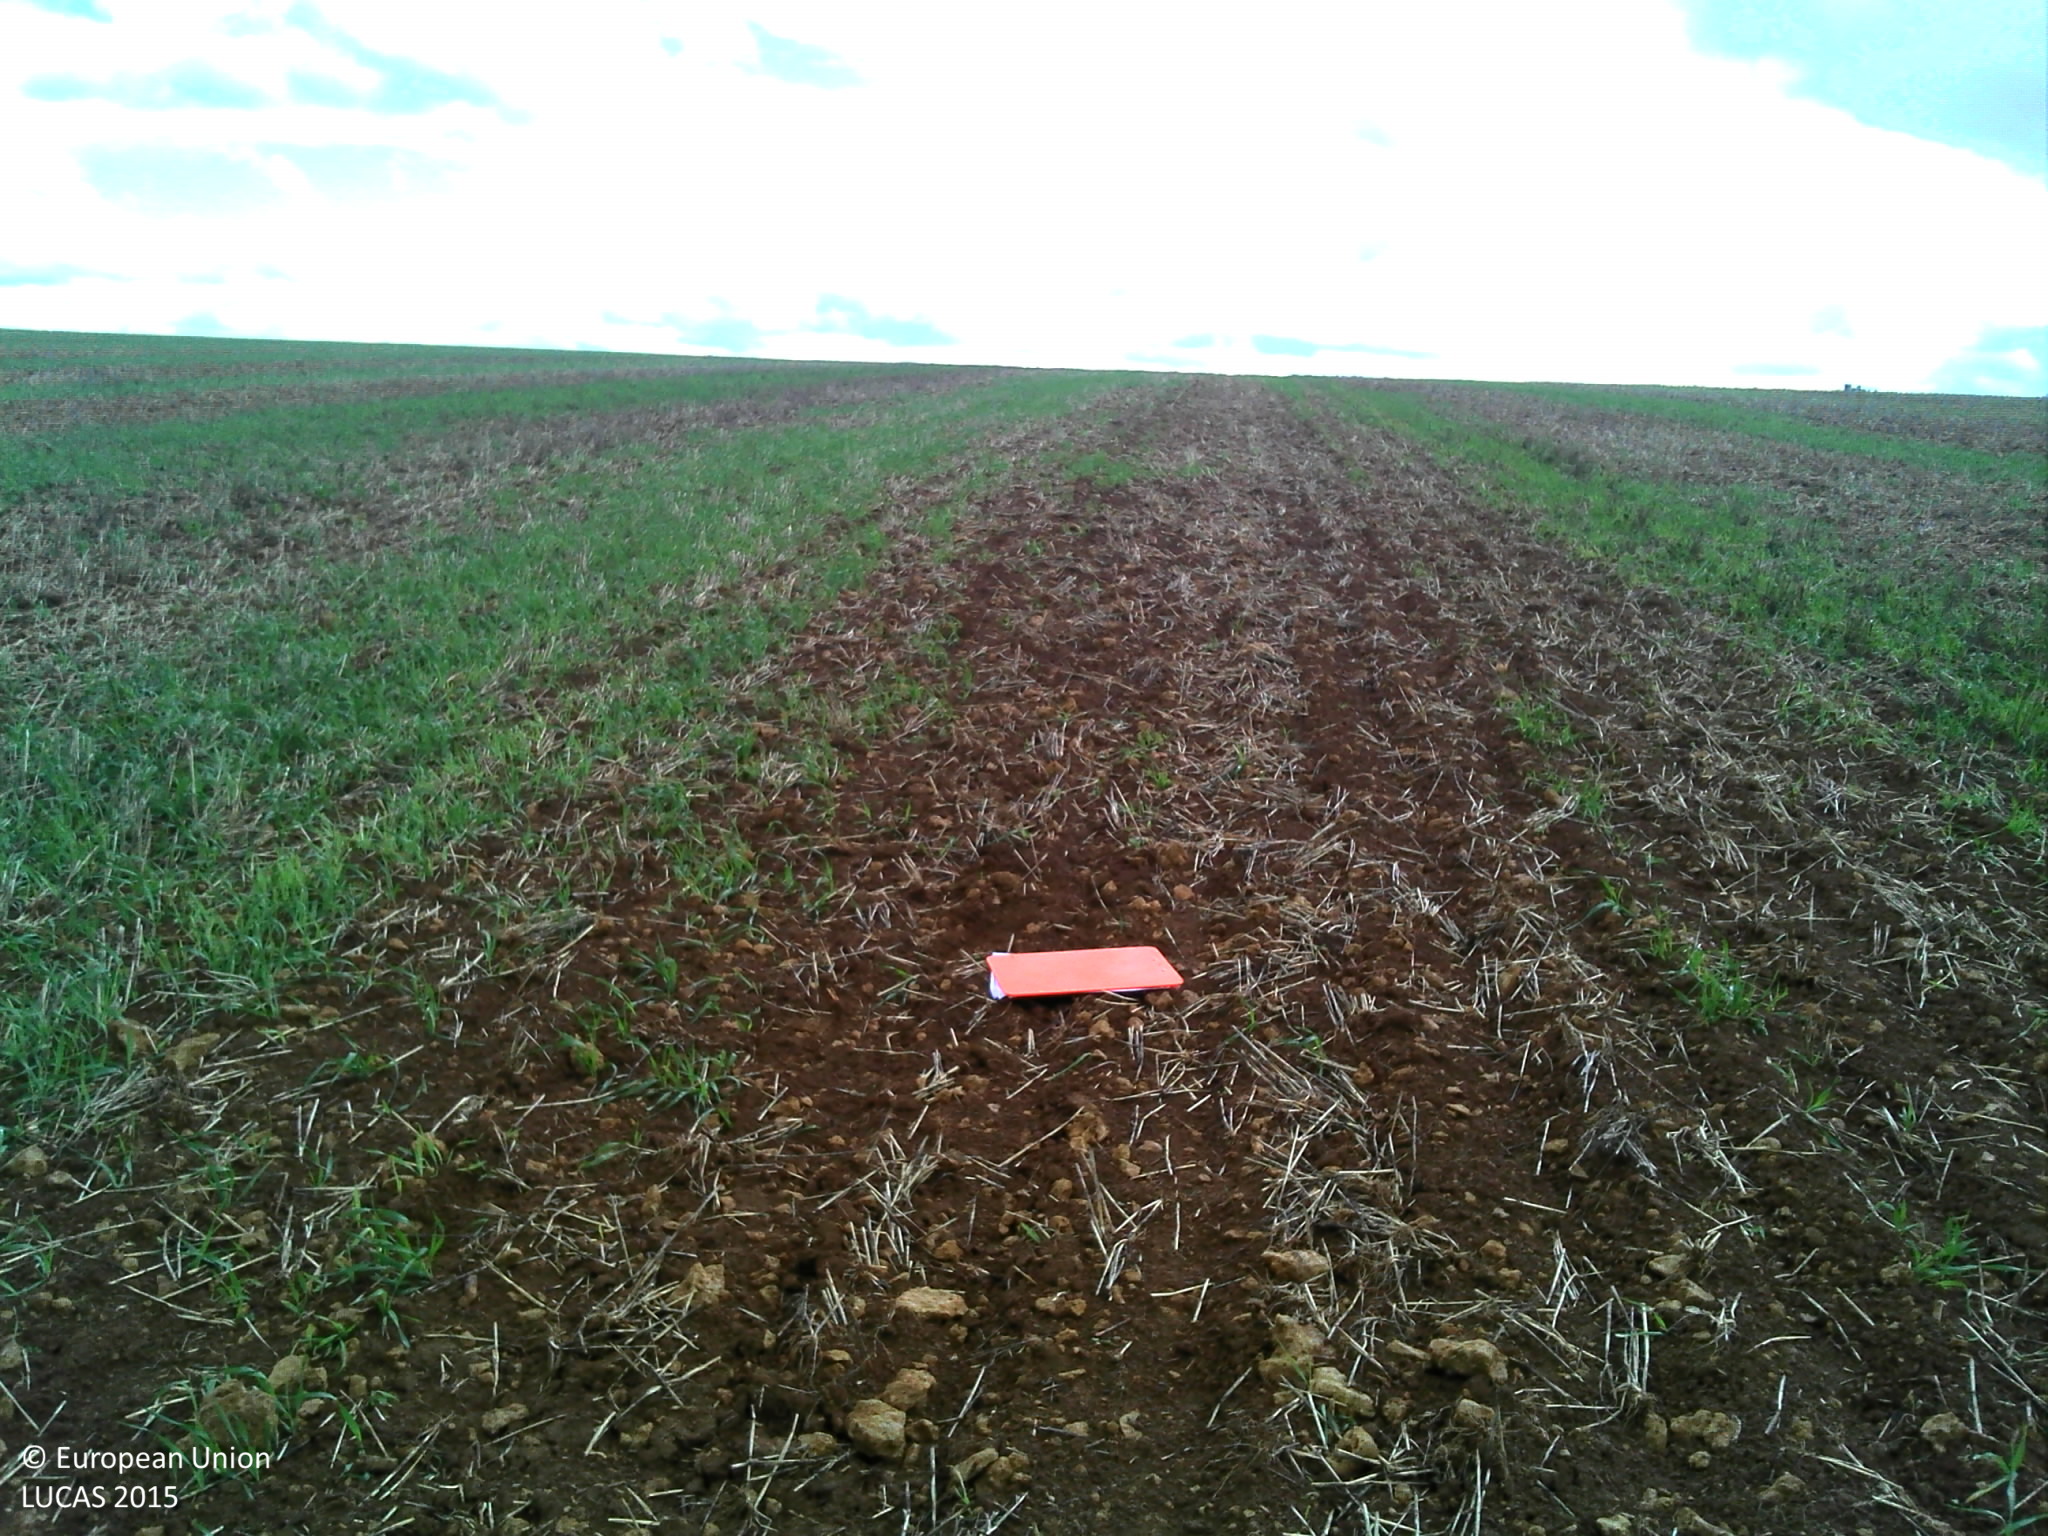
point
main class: Cropland
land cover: Common wheat
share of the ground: < 10 %
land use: Agriculture (excluding fallow land and kitchen gardens)
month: September
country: FR
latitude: 48.8867
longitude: 5.9218
